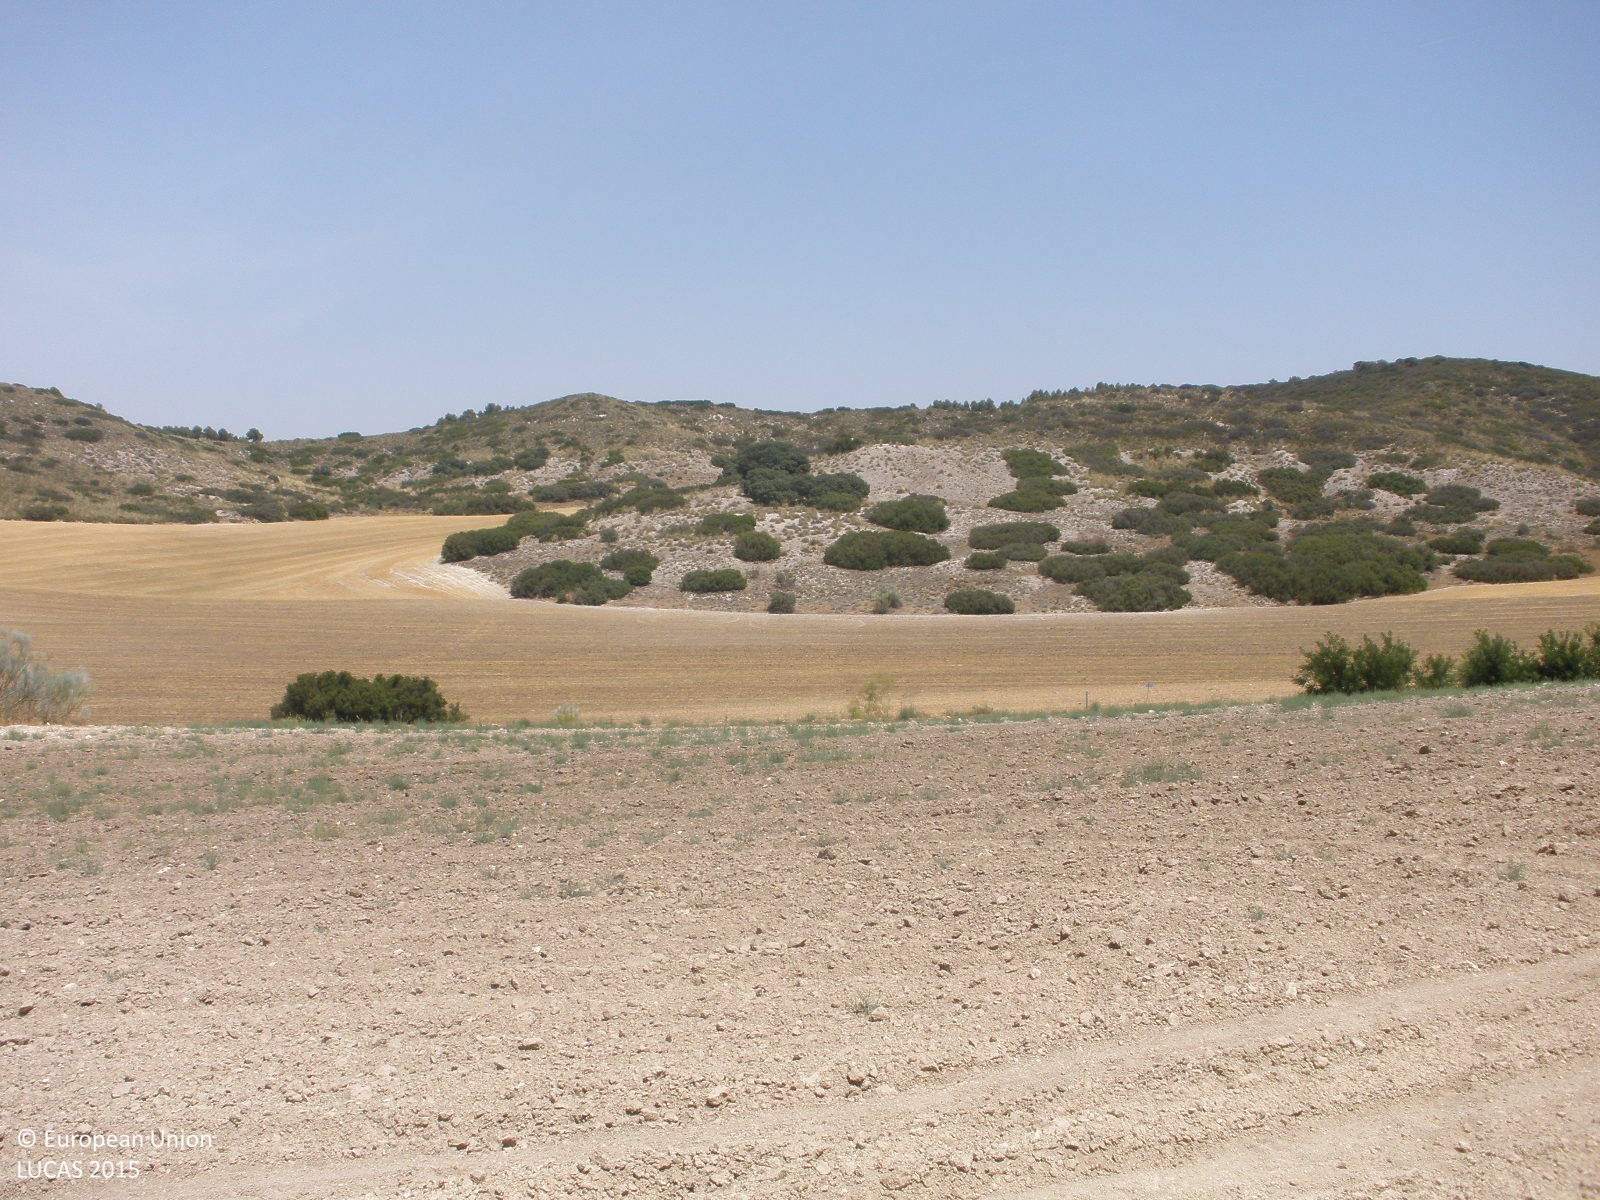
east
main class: Woodland
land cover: Broadleaved woodland
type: broadleaved evergreen forest
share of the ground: > 75 %
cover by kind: broadleaved forest trees 80 %, shrubs 20 %
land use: Semi-natural and natural areas not in use
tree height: < 5 m
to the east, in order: Broadleaved woodland; Other bare soil; Shrubland without tree cover; Paved roads, cycling and walking lanes; Shrubland without tree cover; Other bare soil
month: July
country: ES
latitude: 40.2640
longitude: -3.4965
